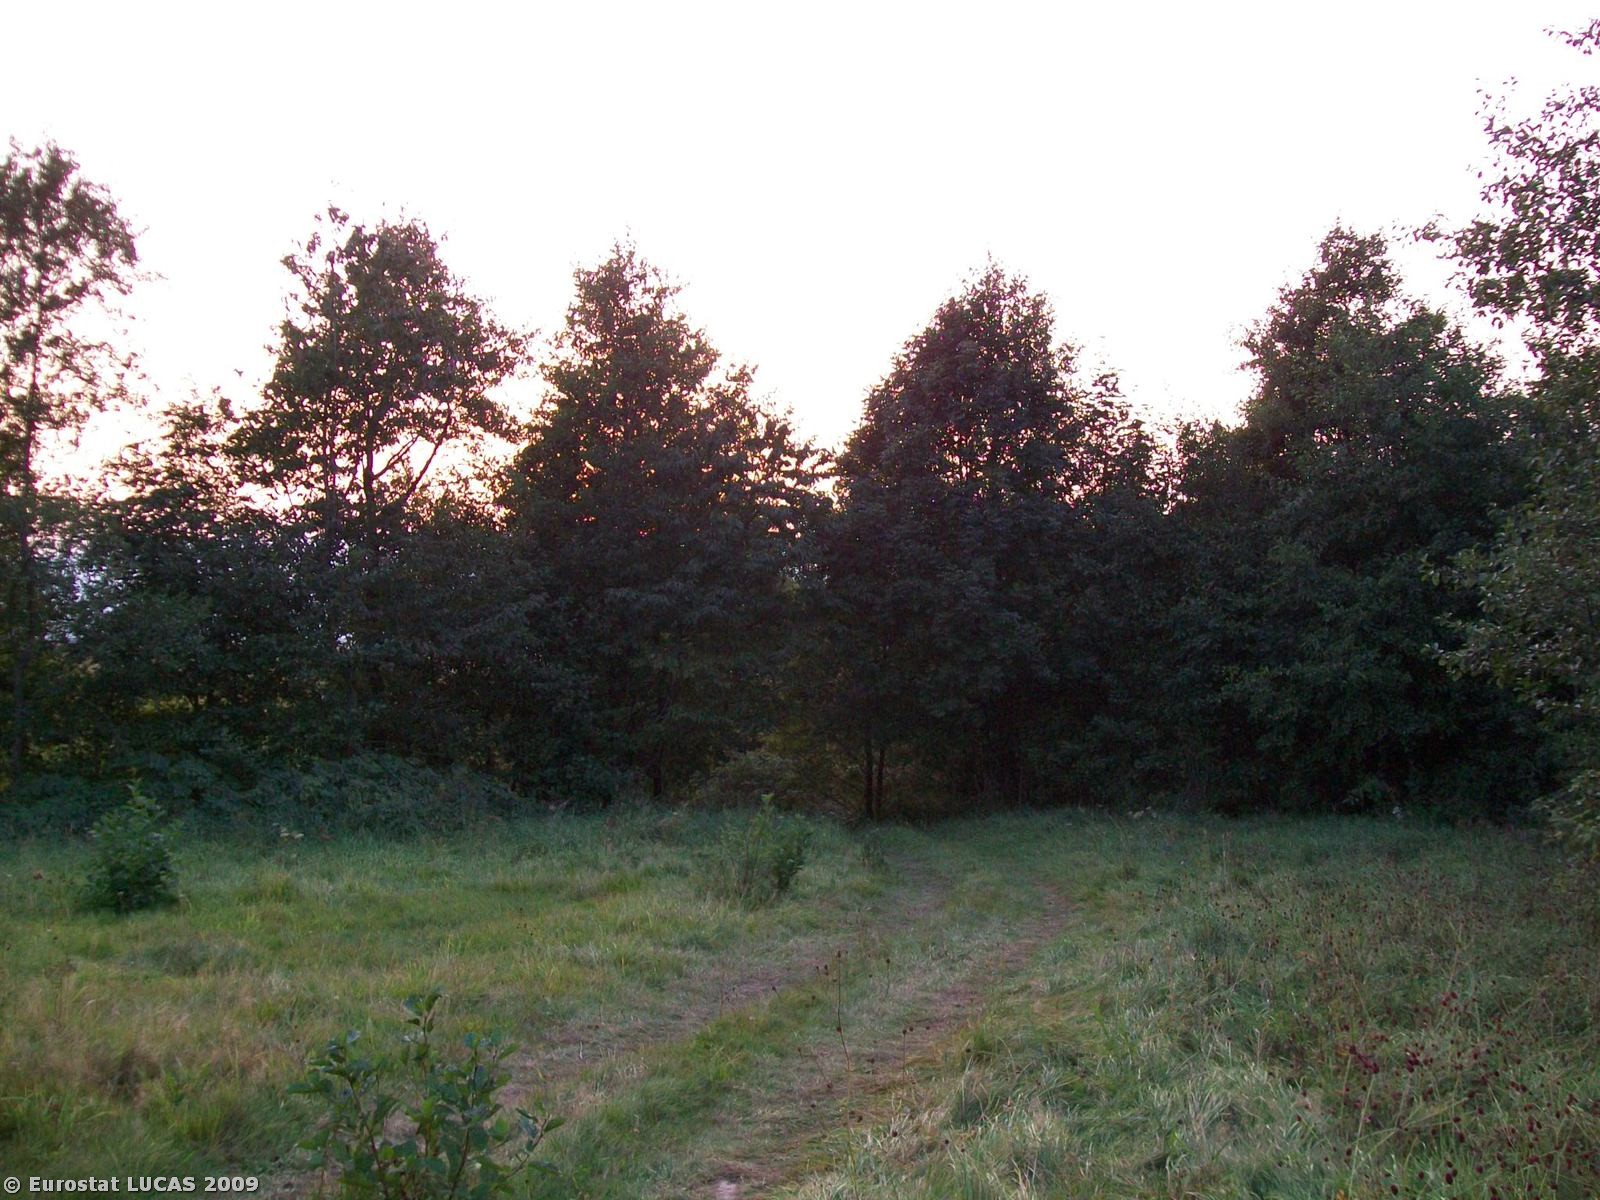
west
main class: Grassland
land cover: Grassland with sparse tree/shrub cover
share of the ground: > 75 %
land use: Unused
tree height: > 5 m
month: September
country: PL
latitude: 50.2578
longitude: 16.6991
